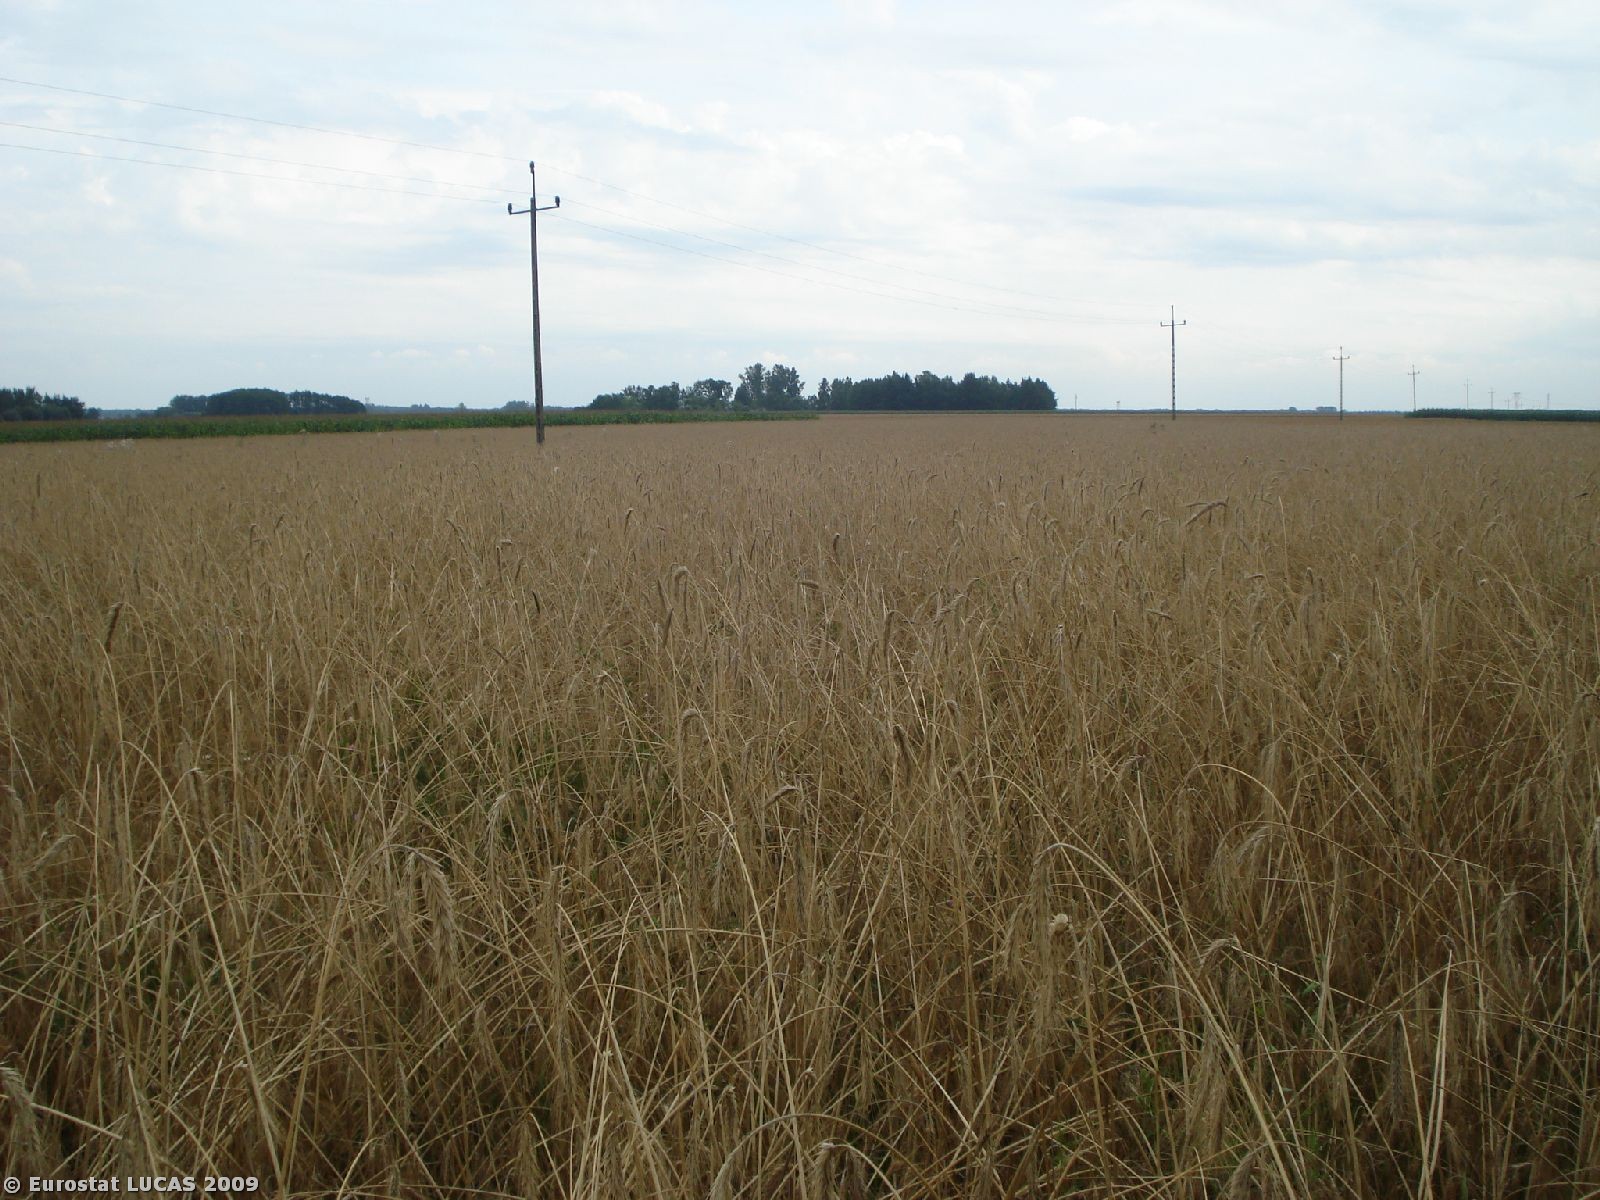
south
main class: Cropland
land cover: Triticale
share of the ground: 25 - 50 %
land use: Agriculture (excluding fallow land and kitchen gardens)
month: August
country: PL
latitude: 52.7430
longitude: 22.4035
